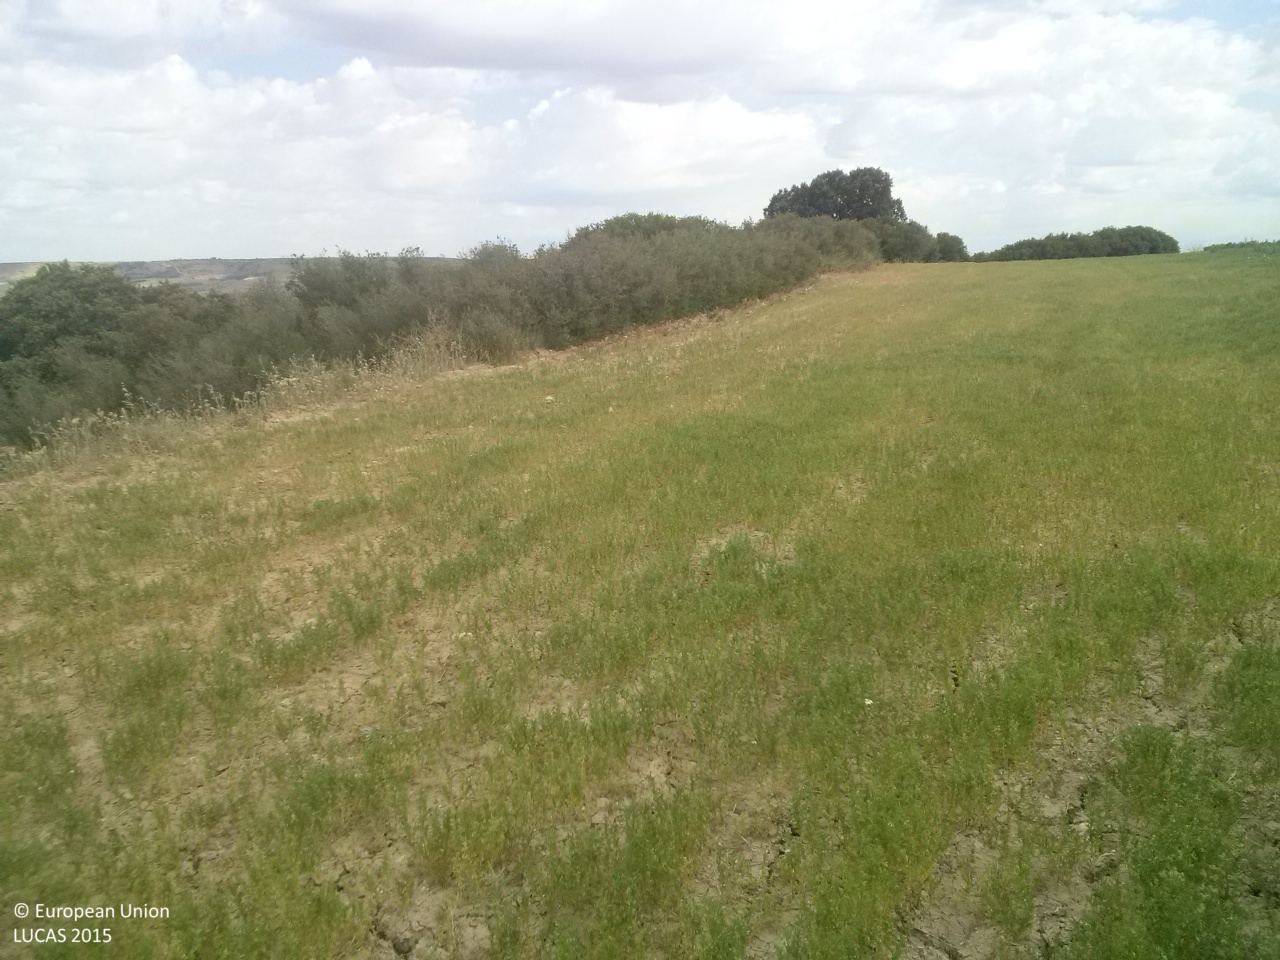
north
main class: Cropland
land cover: Dry pulses
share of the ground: > 75 %
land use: Agriculture (excluding fallow land and kitchen gardens)
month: May
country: ES
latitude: 40.1079
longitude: -2.8935
